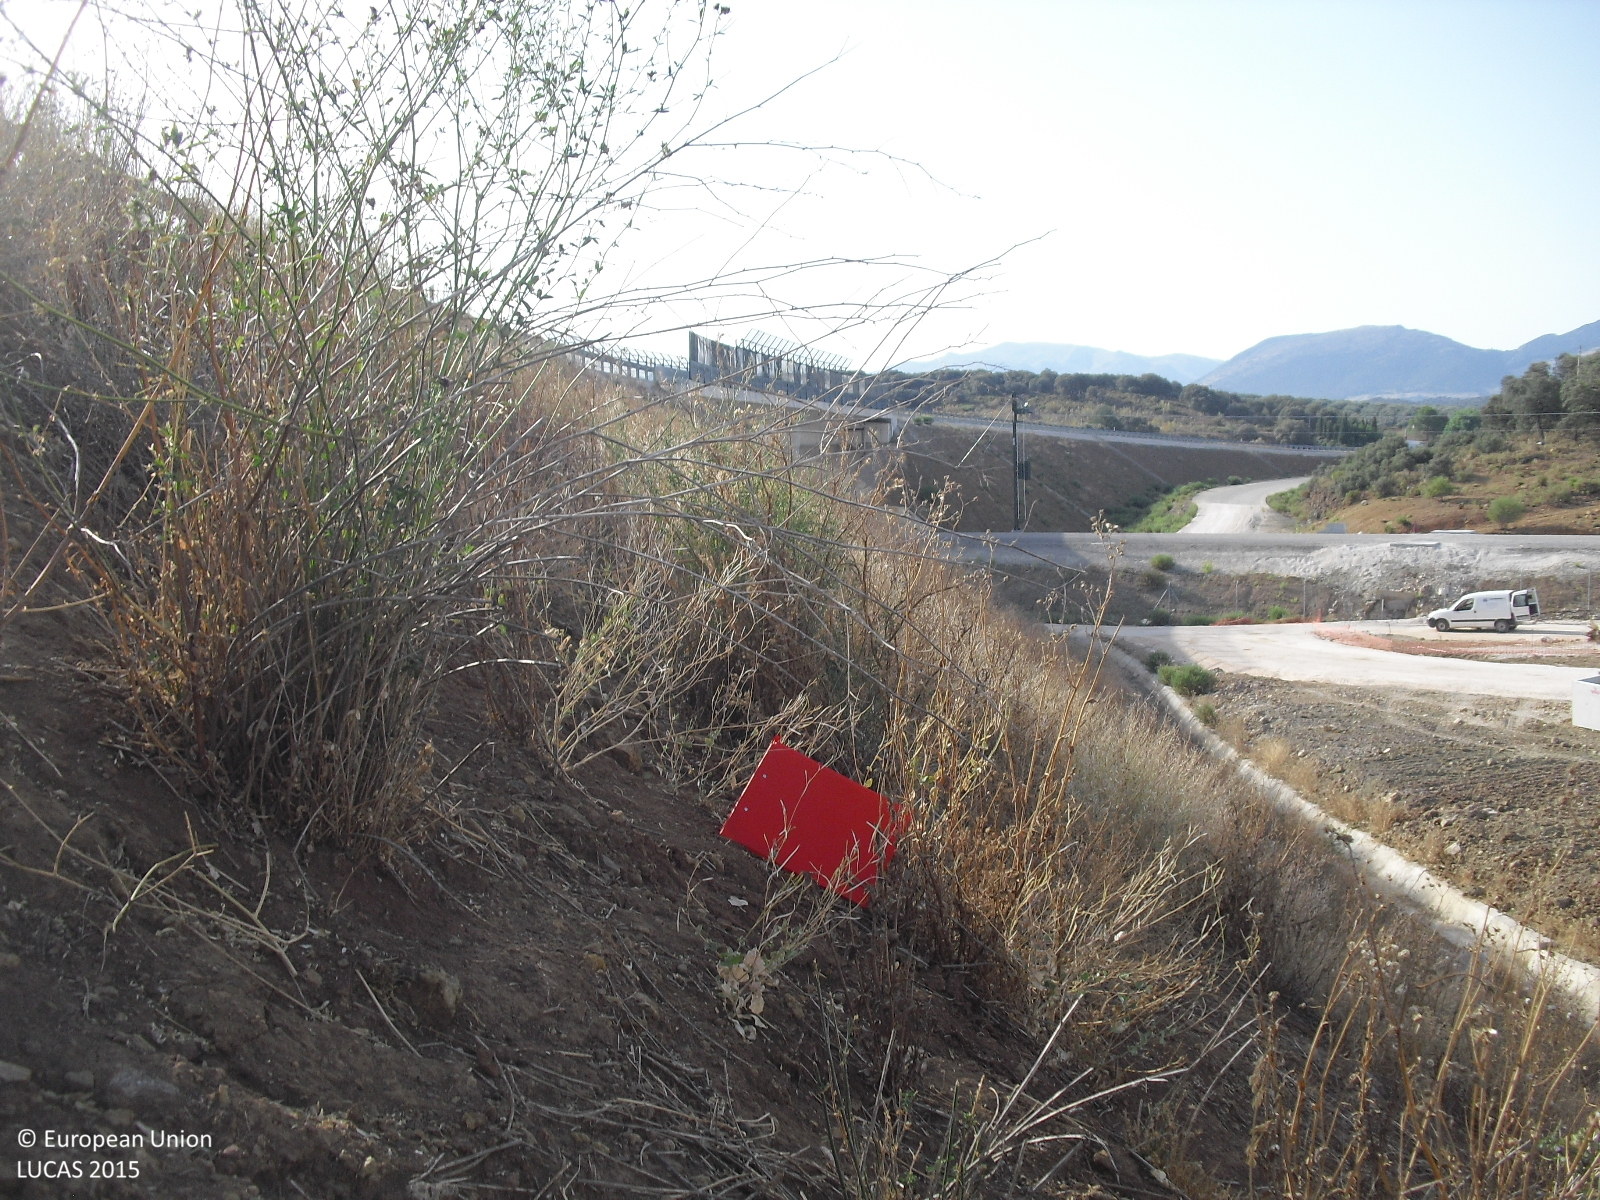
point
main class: Grassland
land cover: Grassland without tree/shrub cover
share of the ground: 25 - 50 %
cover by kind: unconsolidated bare surface 65 %, herbaceous plants 35 %
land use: Protection infrastructures
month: July
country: ES
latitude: 37.1381
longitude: -4.3040
